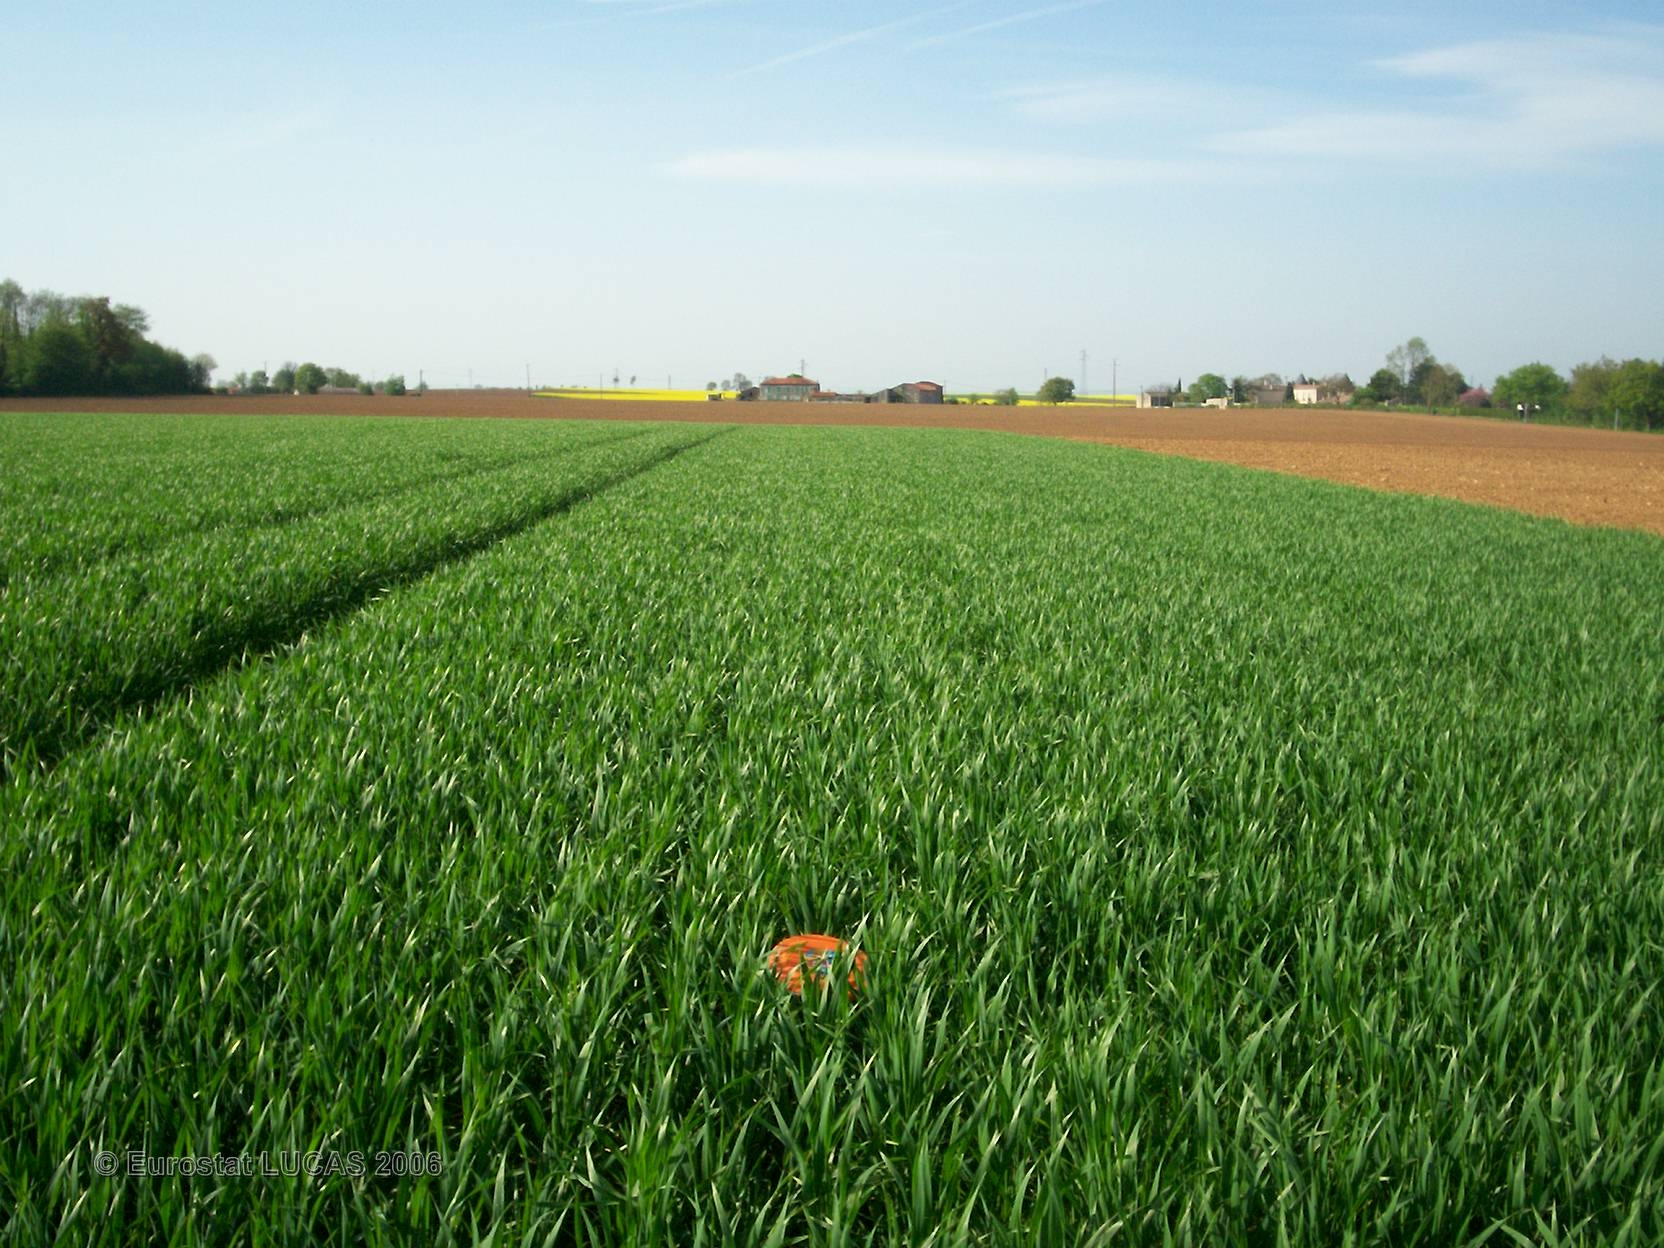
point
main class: Cropland
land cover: Common wheat
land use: Agriculture (excluding fallow land and kitchen gardens)
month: May
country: FR
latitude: 46.2382
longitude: -0.2548
